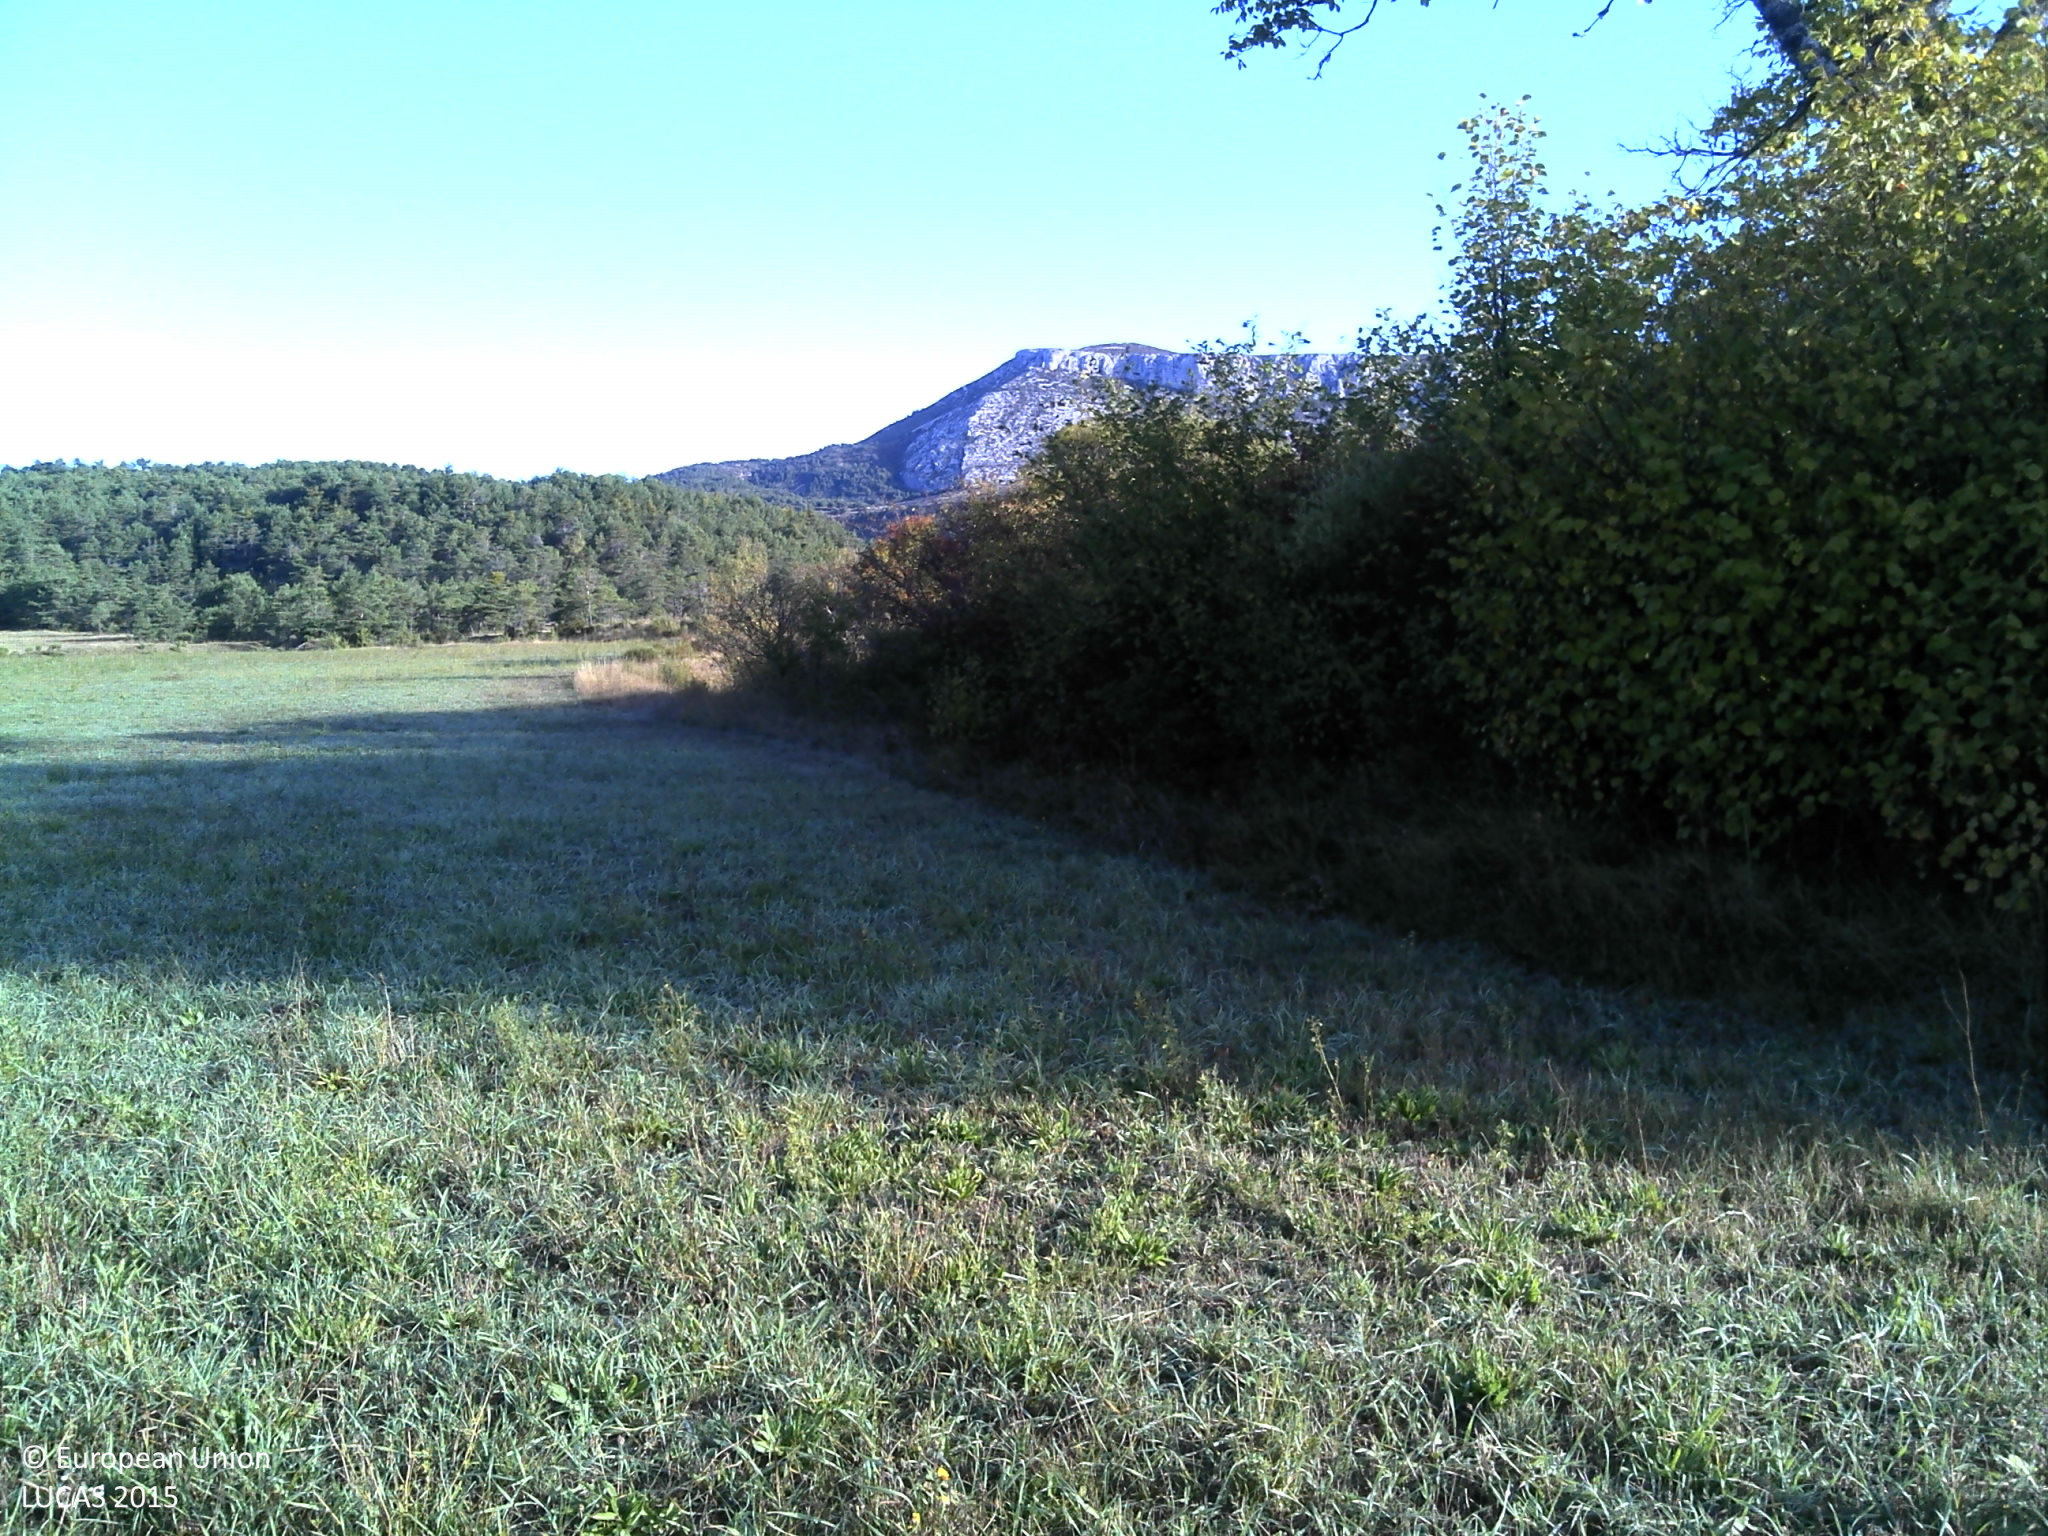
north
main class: Grassland
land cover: Grassland without tree/shrub cover
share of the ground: > 75 %
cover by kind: herbaceous plants 90 %, unconsolidated bare surface 10 %
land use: Agriculture (excluding fallow land and kitchen gardens)
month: September
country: FR
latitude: 43.7161
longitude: 6.5698
